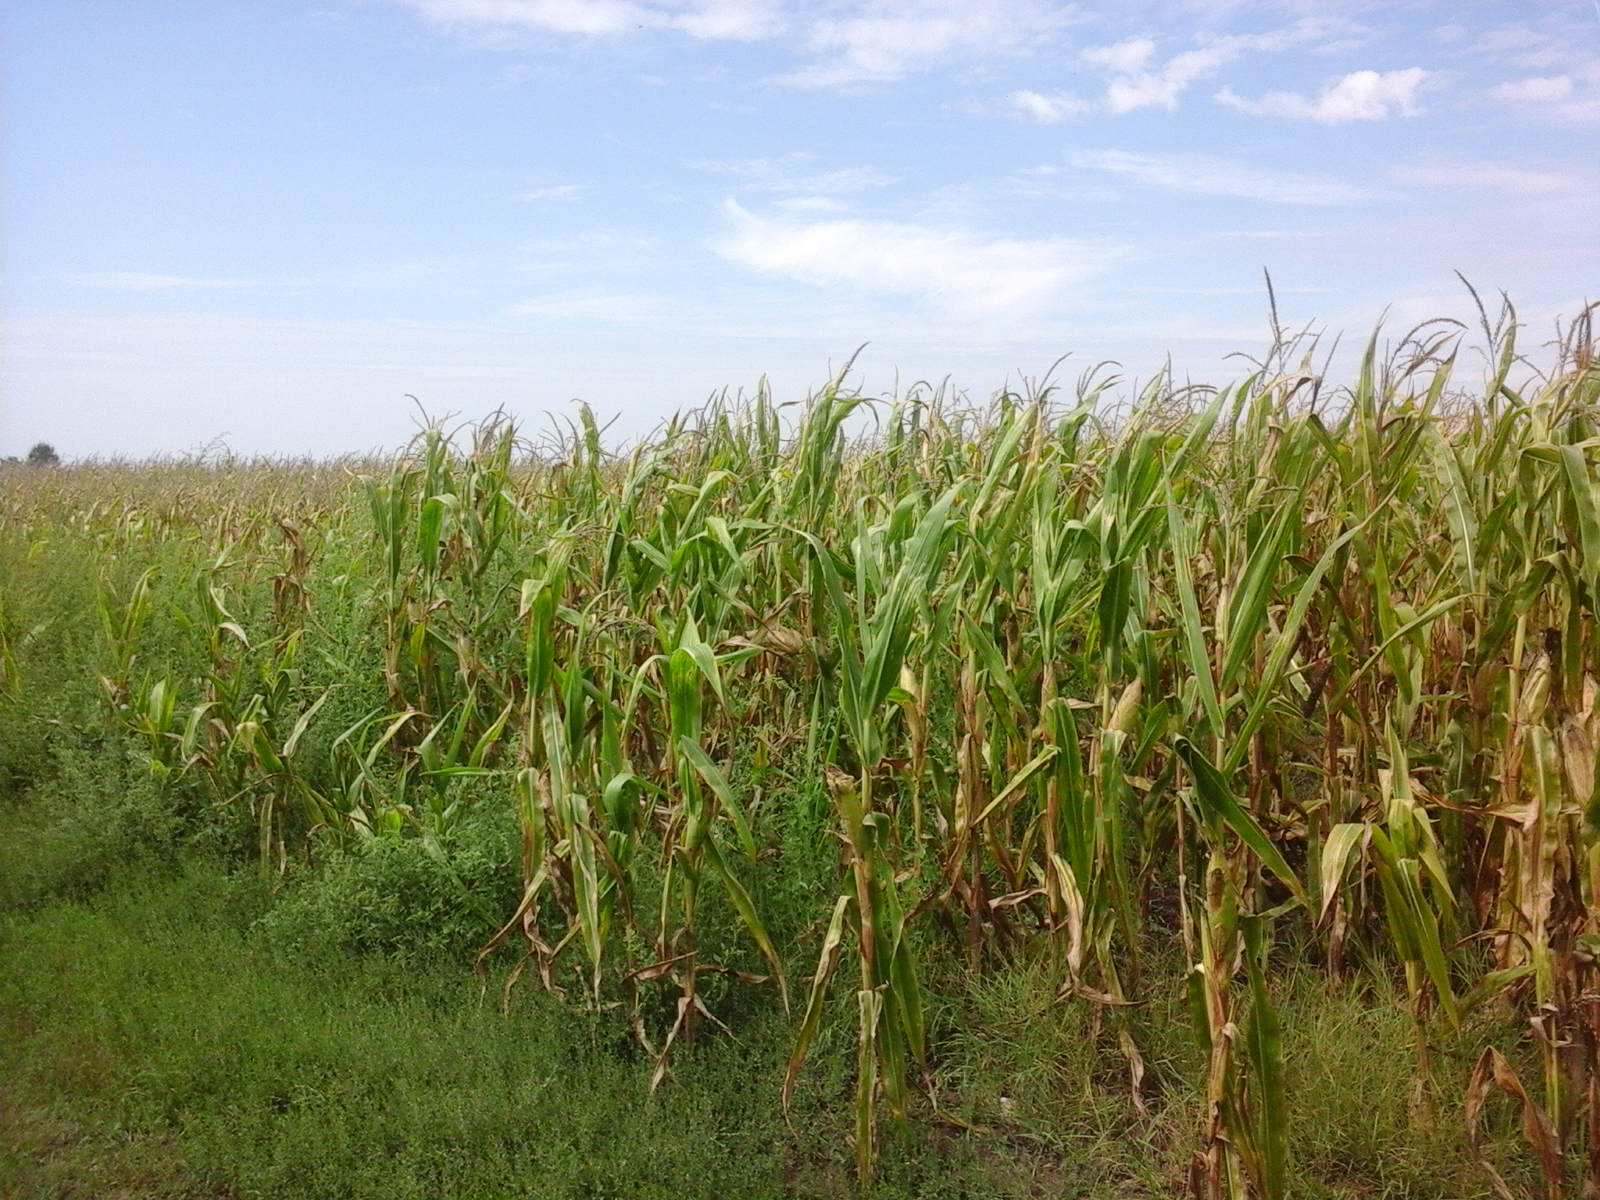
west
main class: Cropland
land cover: Maize
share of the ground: > 75 %
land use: Agriculture (excluding fallow land and kitchen gardens)
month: August
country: RO
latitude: 46.5018
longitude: 21.4125
